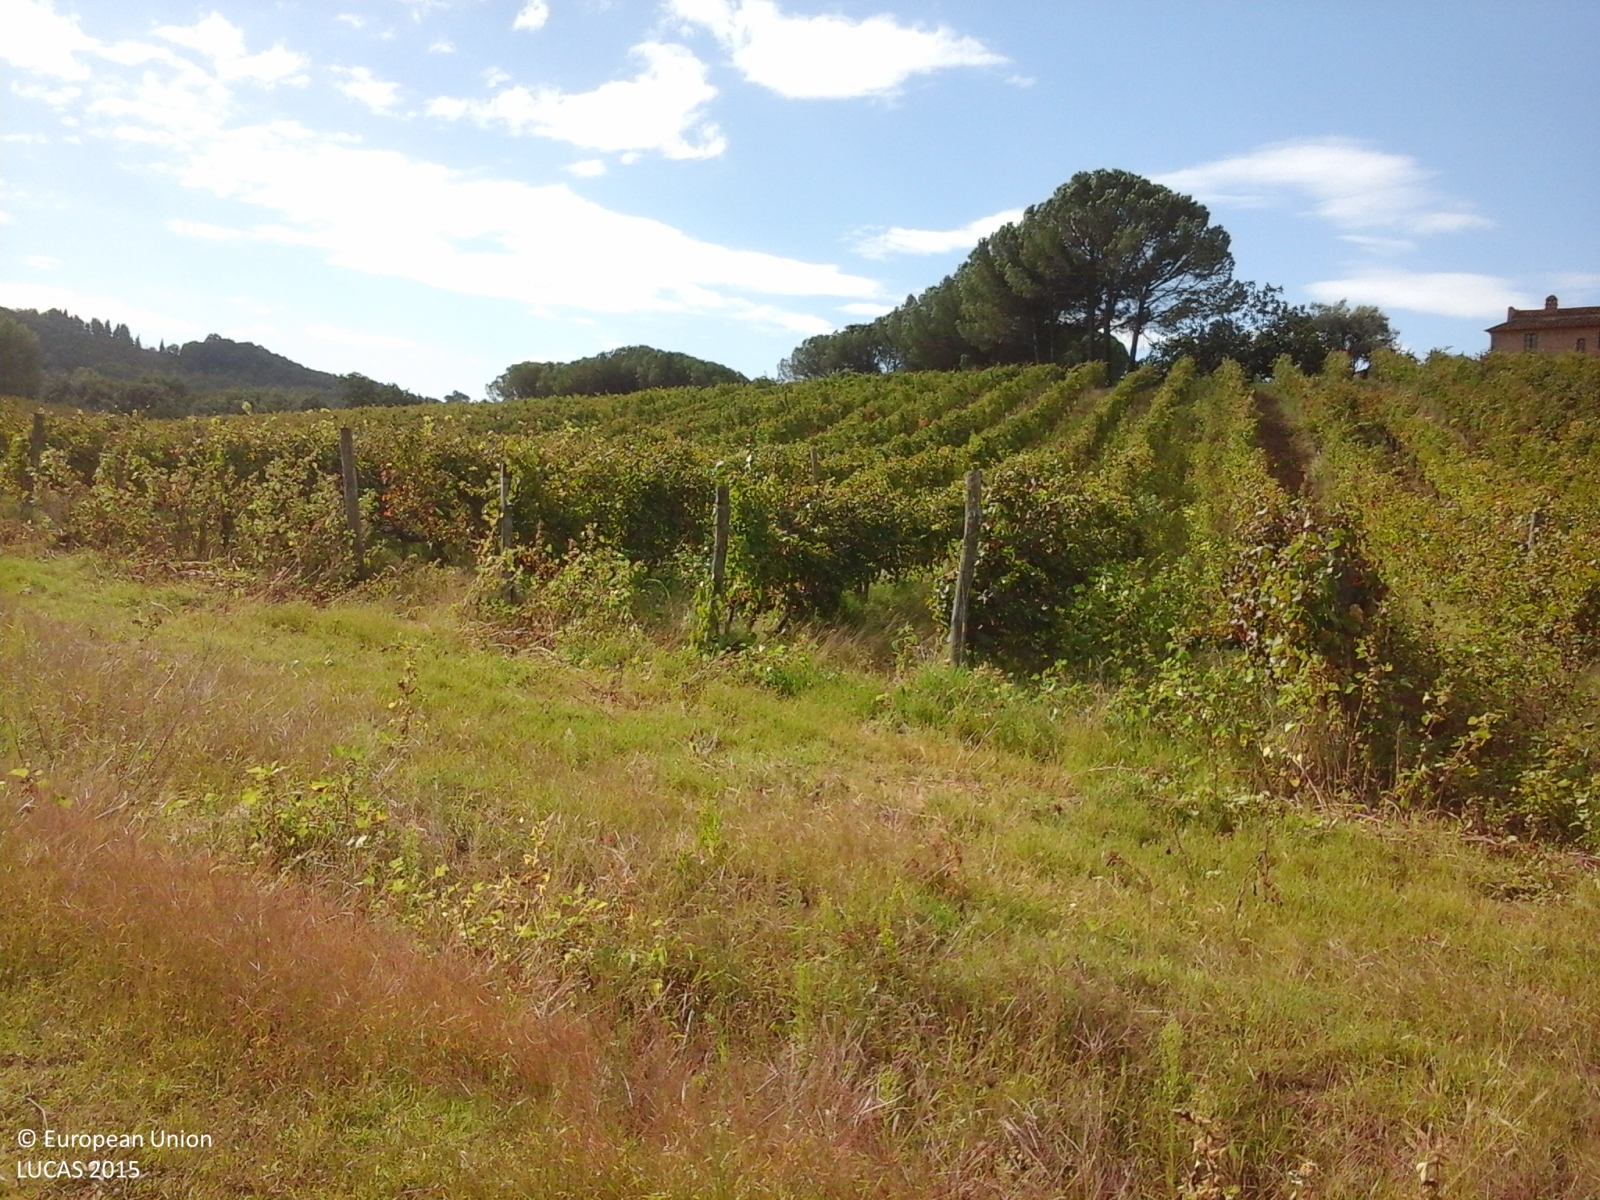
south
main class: Cropland
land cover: Vineyards
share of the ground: > 75 %
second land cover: Grassland without tree/shrub cover
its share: > 75 %
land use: Agriculture (excluding fallow land and kitchen gardens)
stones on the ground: < 10 %
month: August
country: IT
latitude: 43.3384
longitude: 10.6026
